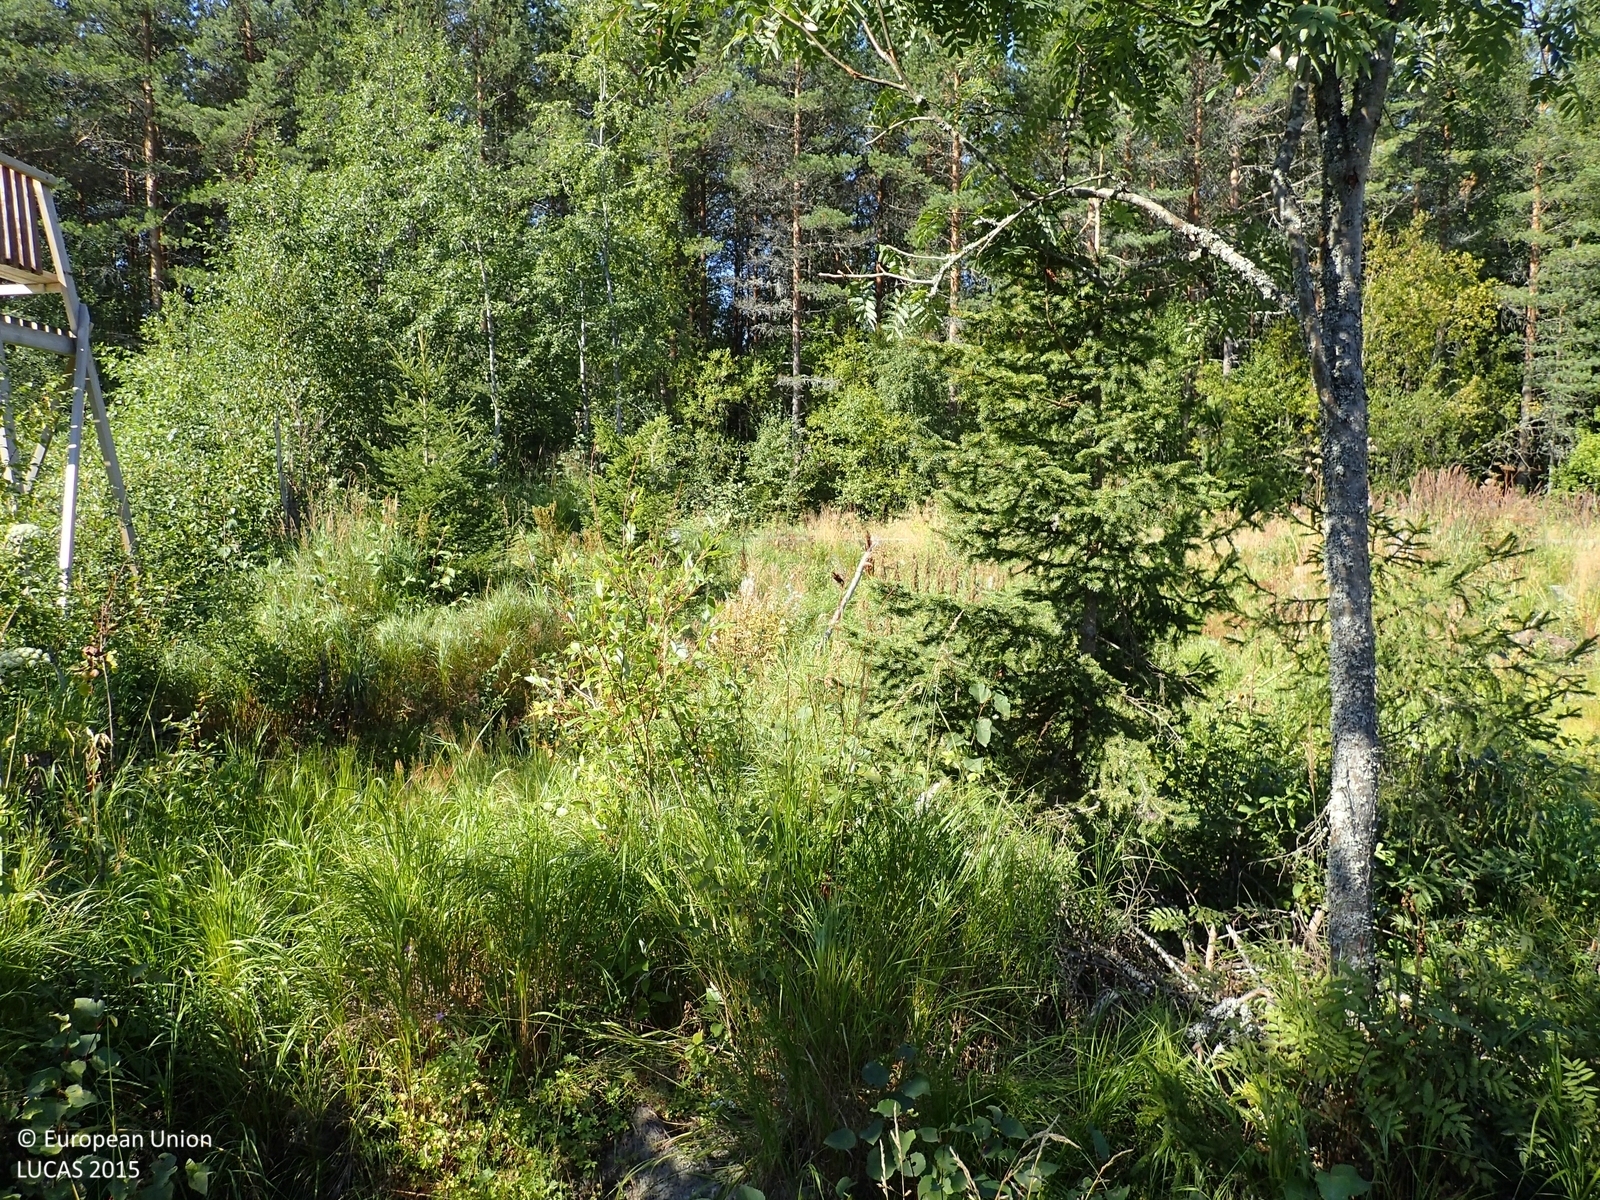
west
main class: Grassland
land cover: Grassland with sparse tree/shrub cover
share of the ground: > 75 %
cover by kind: herbaceous plants 95 %, broadleaved forest trees 5 %
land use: Forestry
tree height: < 5 m
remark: Clear cut
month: August
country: FI
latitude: 62.4267
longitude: 21.7236
